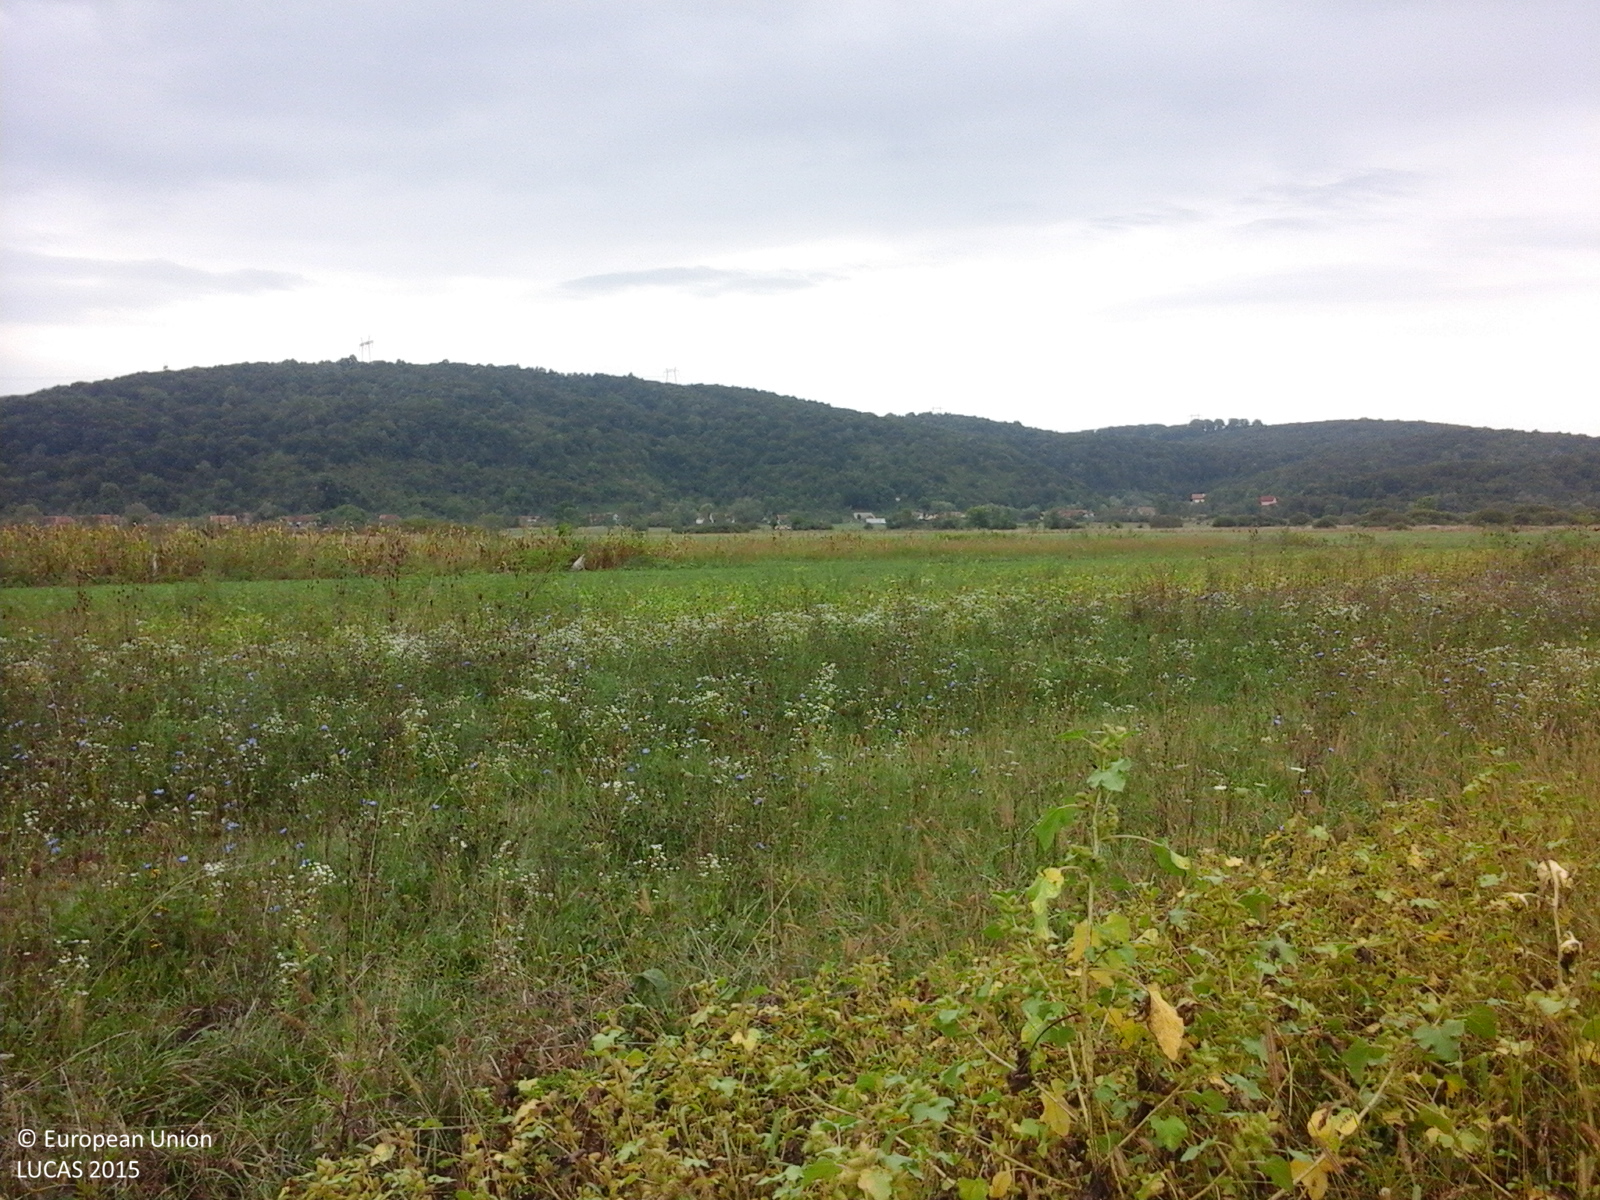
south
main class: Grassland
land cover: Spontaneously vegetated surfaces
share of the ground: > 75 %
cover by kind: herbaceous plants 100 %
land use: Fallow land
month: September
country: RO
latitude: 45.9877
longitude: 22.2705
